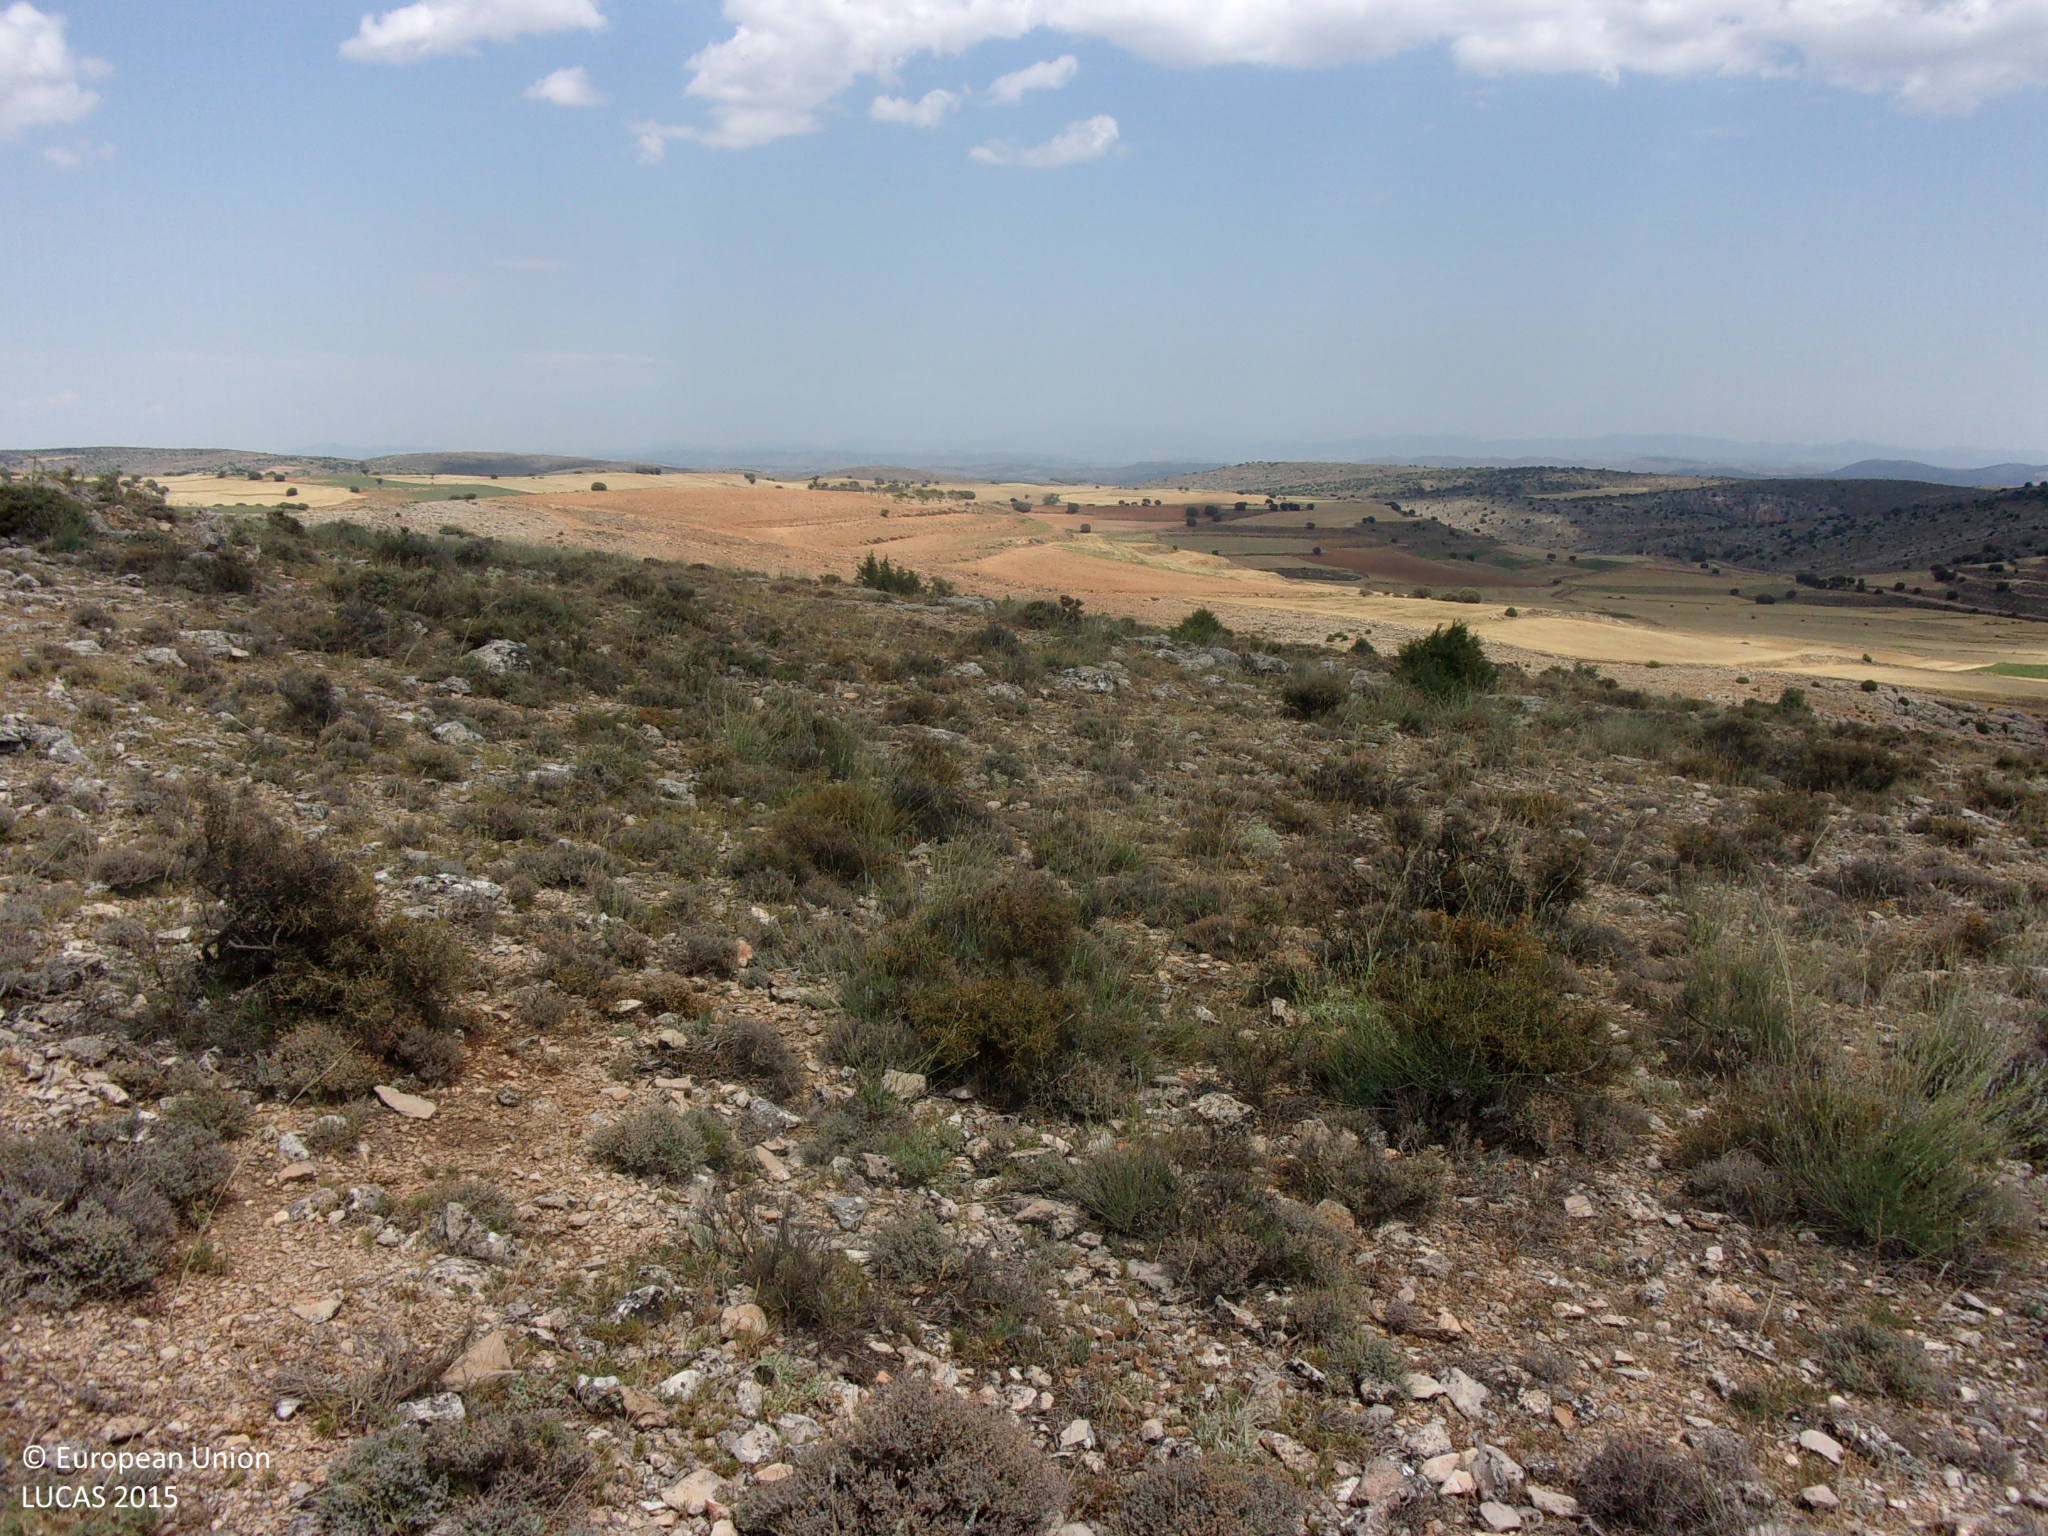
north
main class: Shrubland
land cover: Shrubland without tree cover
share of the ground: 50 - 75 %
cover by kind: consolidated bare surface 50 %, shrubs 40 %, herbaceous plants 10 %
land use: Semi-natural and natural areas not in use
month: July
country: ES
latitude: 41.1372
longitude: -1.8308
